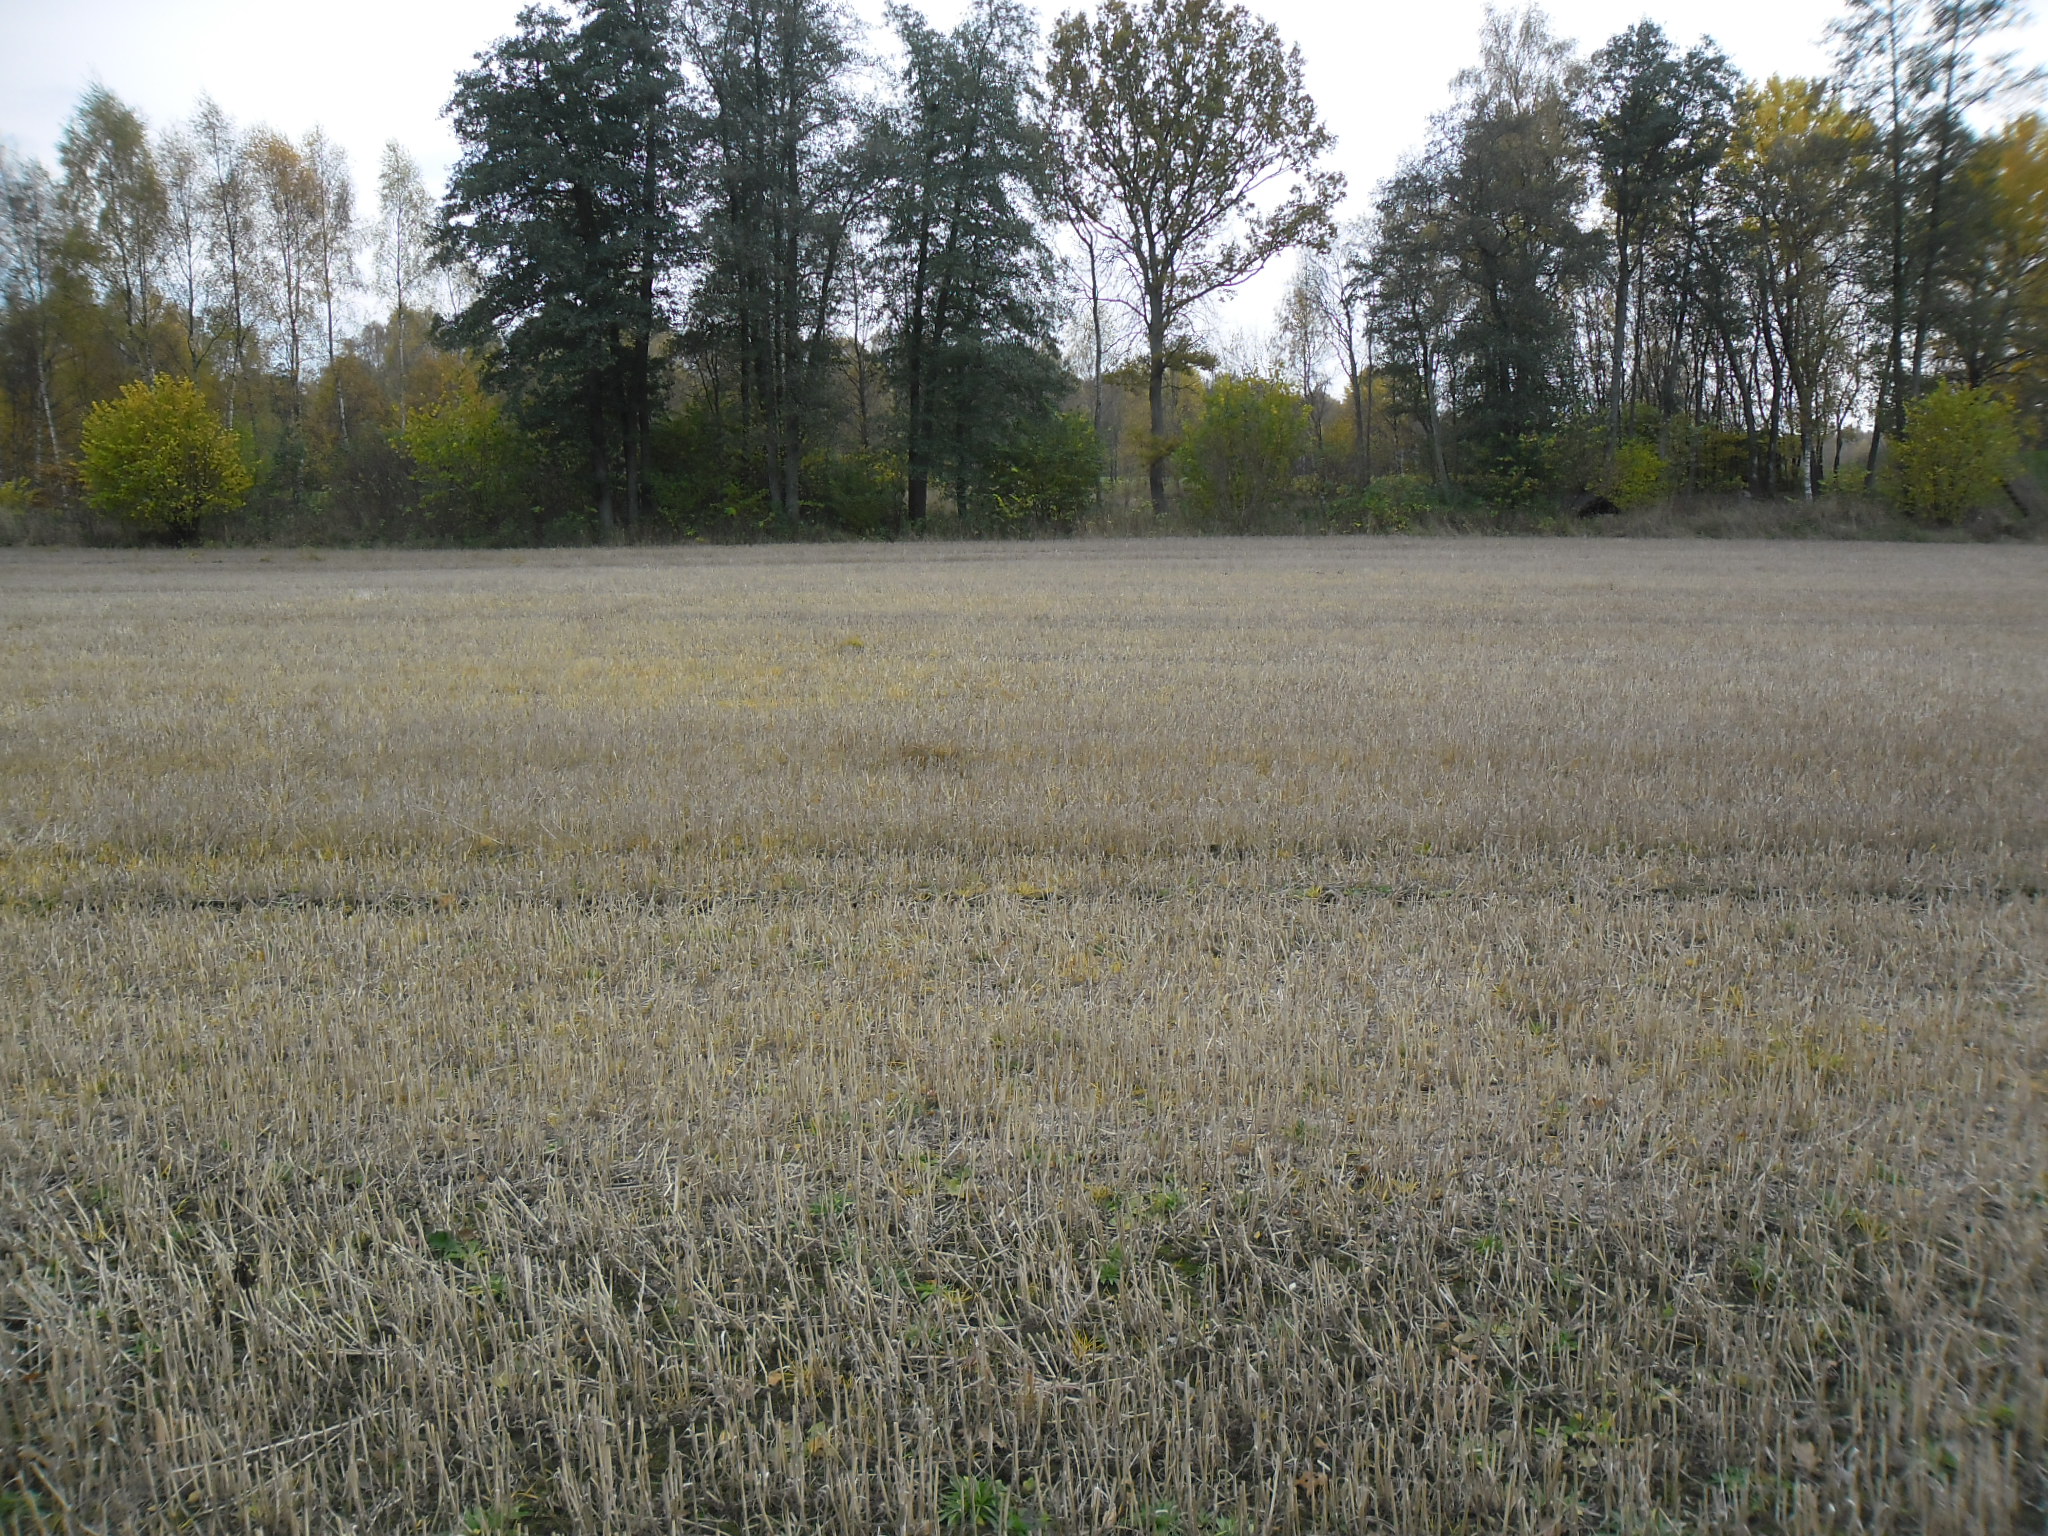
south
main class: Cropland
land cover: Common wheat
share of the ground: 25 - 50 %
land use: Agriculture (excluding fallow land and kitchen gardens)
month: October
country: SE
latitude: 56.1700
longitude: 13.7179
